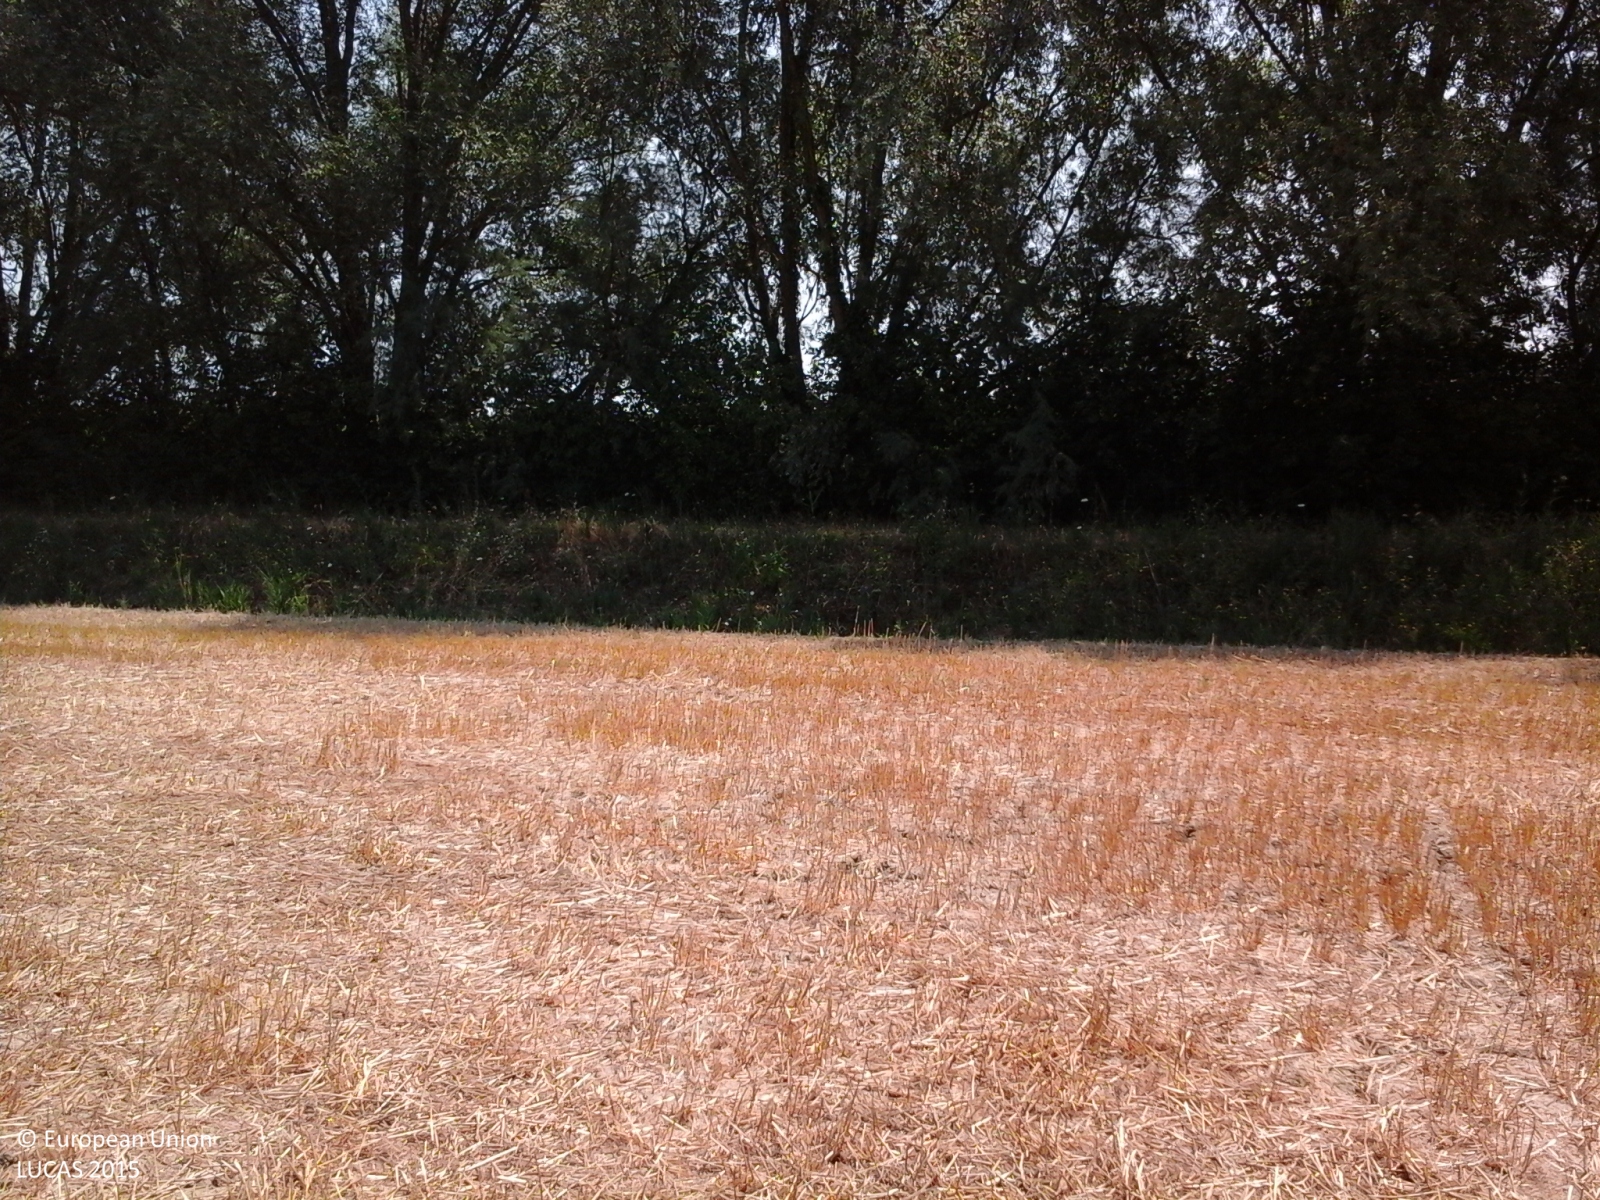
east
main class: Cropland
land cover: Barley
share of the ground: > 75 %
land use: Agriculture (excluding fallow land and kitchen gardens)
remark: Harvested field
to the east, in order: Barley; Grass margins; Ditches and canals; Grass margins; Tracks; Abandoned hedges; Inland fresh water bodies
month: July
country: IT
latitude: 44.6449
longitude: 11.5979
